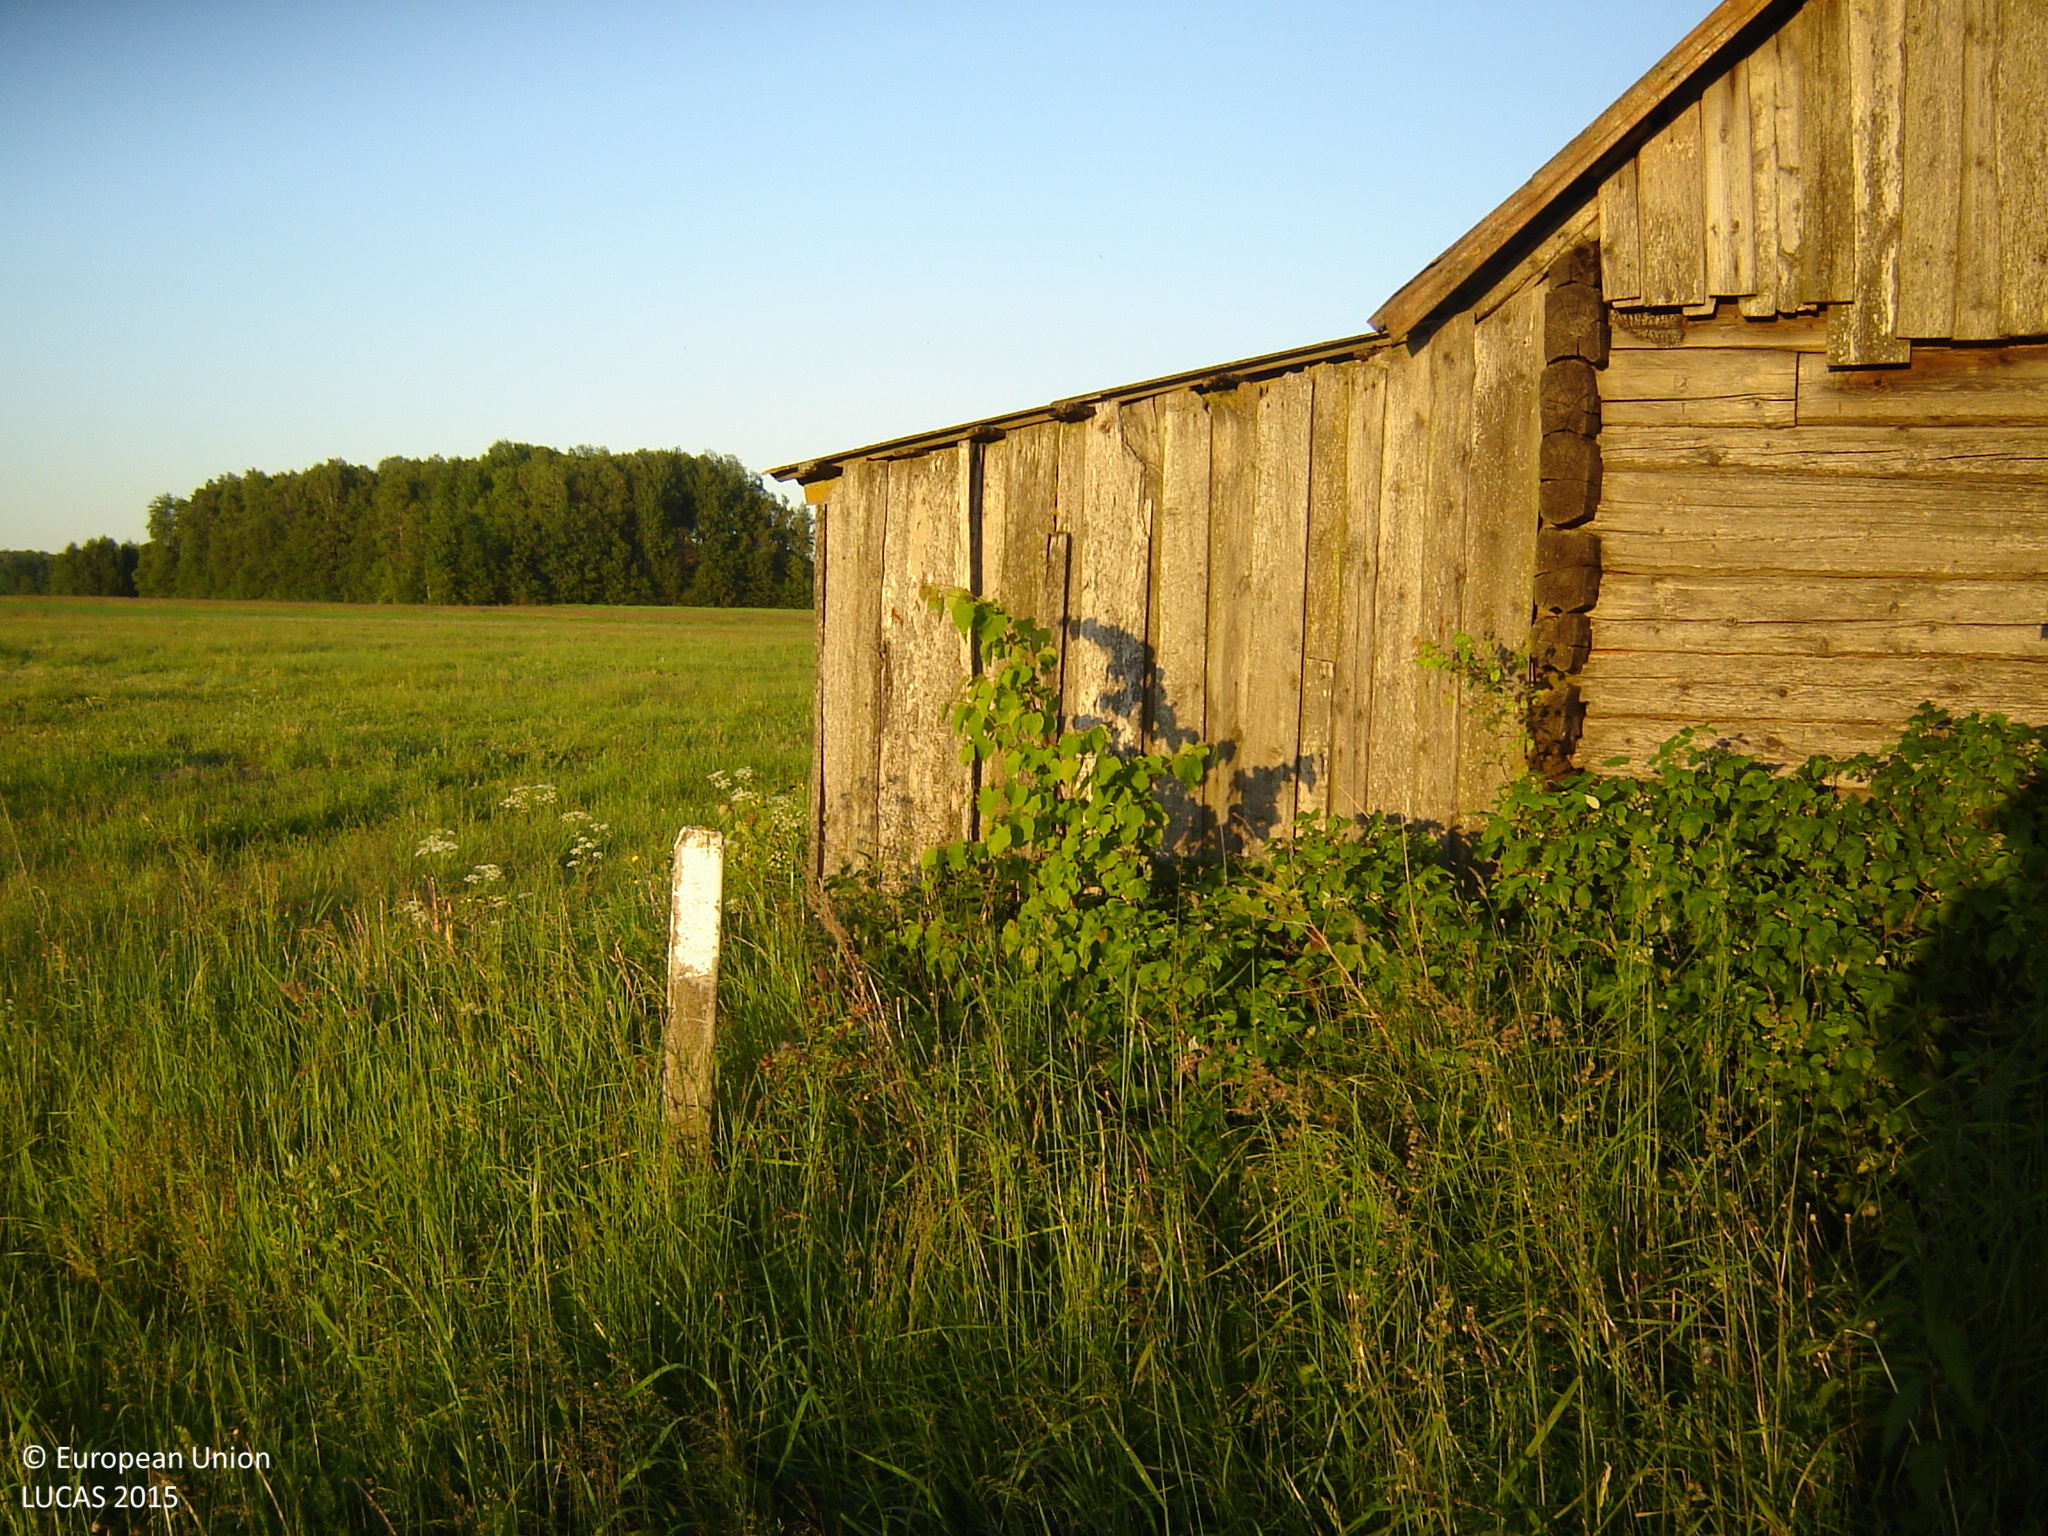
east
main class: Grassland
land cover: Grassland without tree/shrub cover
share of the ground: > 75 %
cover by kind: herbaceous plants 100 %
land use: Agriculture (excluding fallow land and kitchen gardens)
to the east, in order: Grassland without tree/shrub cover; Artificial constructions in urban areas; Grassland without tree/shrub cover; Tracks; Grassland without tree/shrub cover; Oats
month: June
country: LT
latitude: 55.5819
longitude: 25.2354
